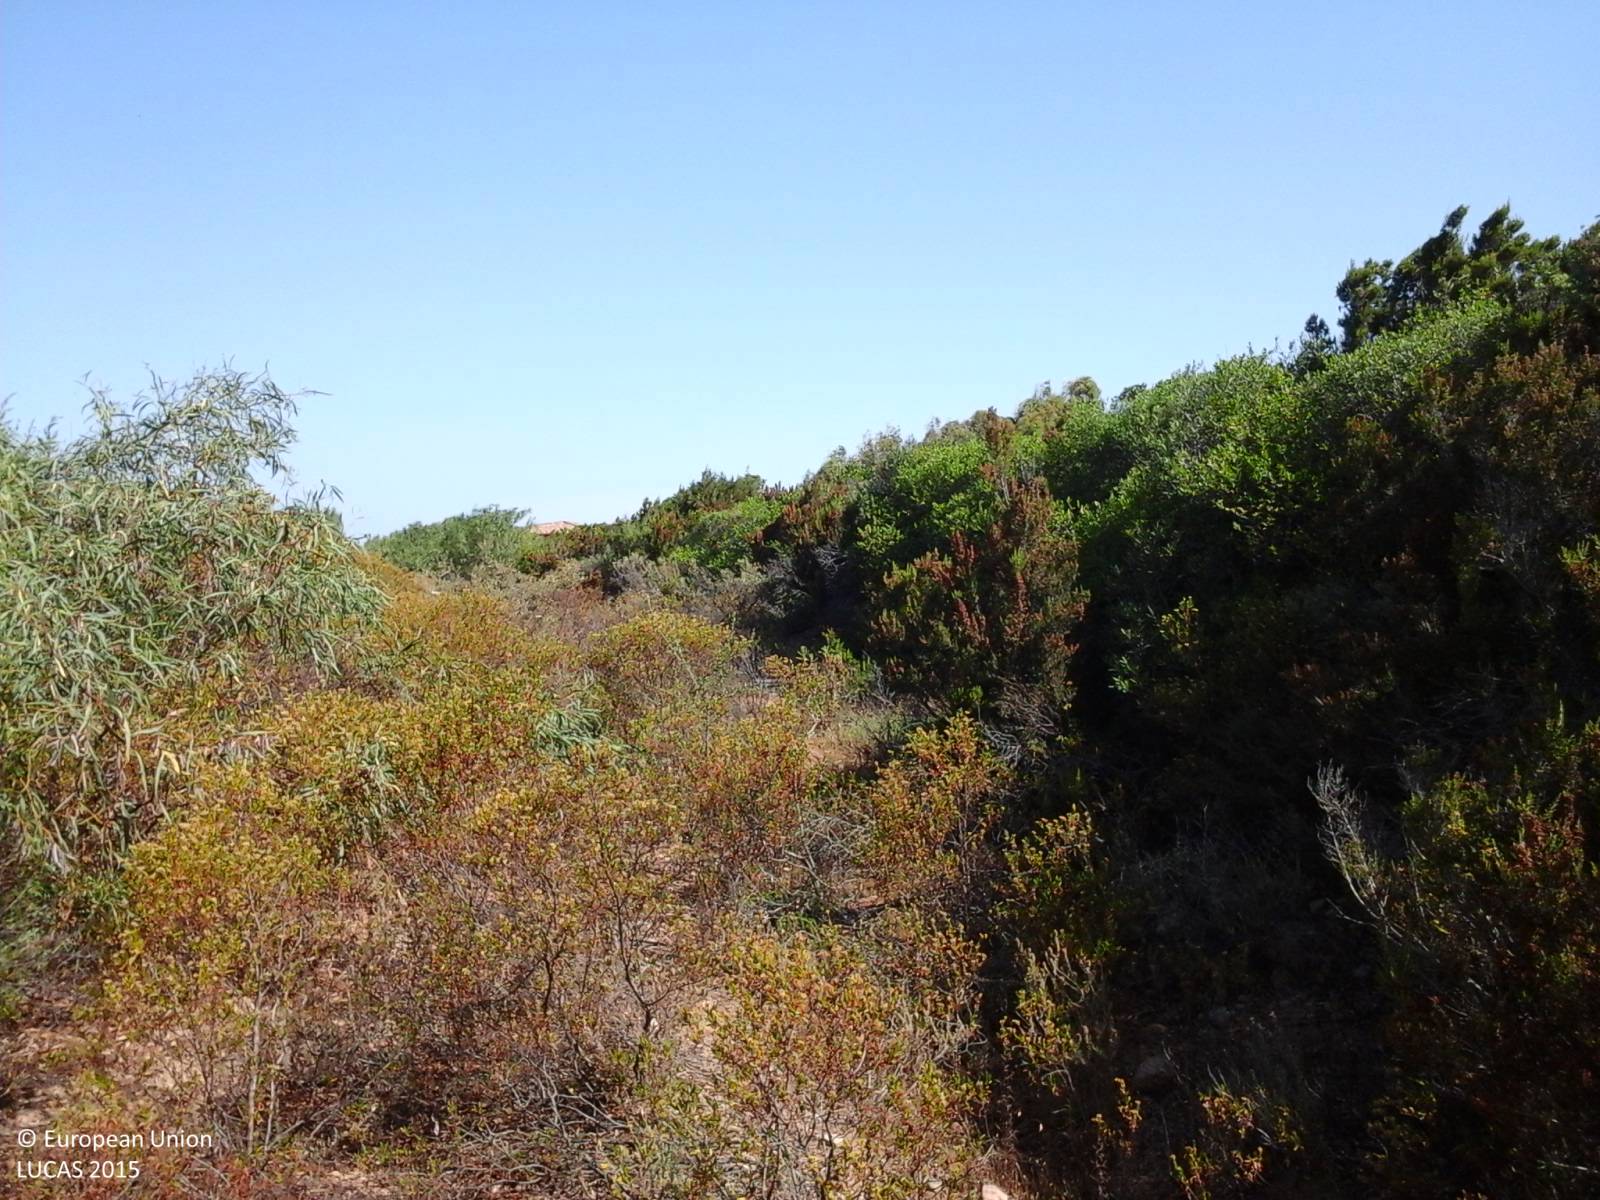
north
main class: Shrubland
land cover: Shrubland without tree cover
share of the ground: > 75 %
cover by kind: shrubs 65 %, herbaceous plants 20 %, unconsolidated bare surface 15 %
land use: Semi-natural and natural areas not in use
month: June
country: IT
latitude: 41.0212
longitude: 8.8991
